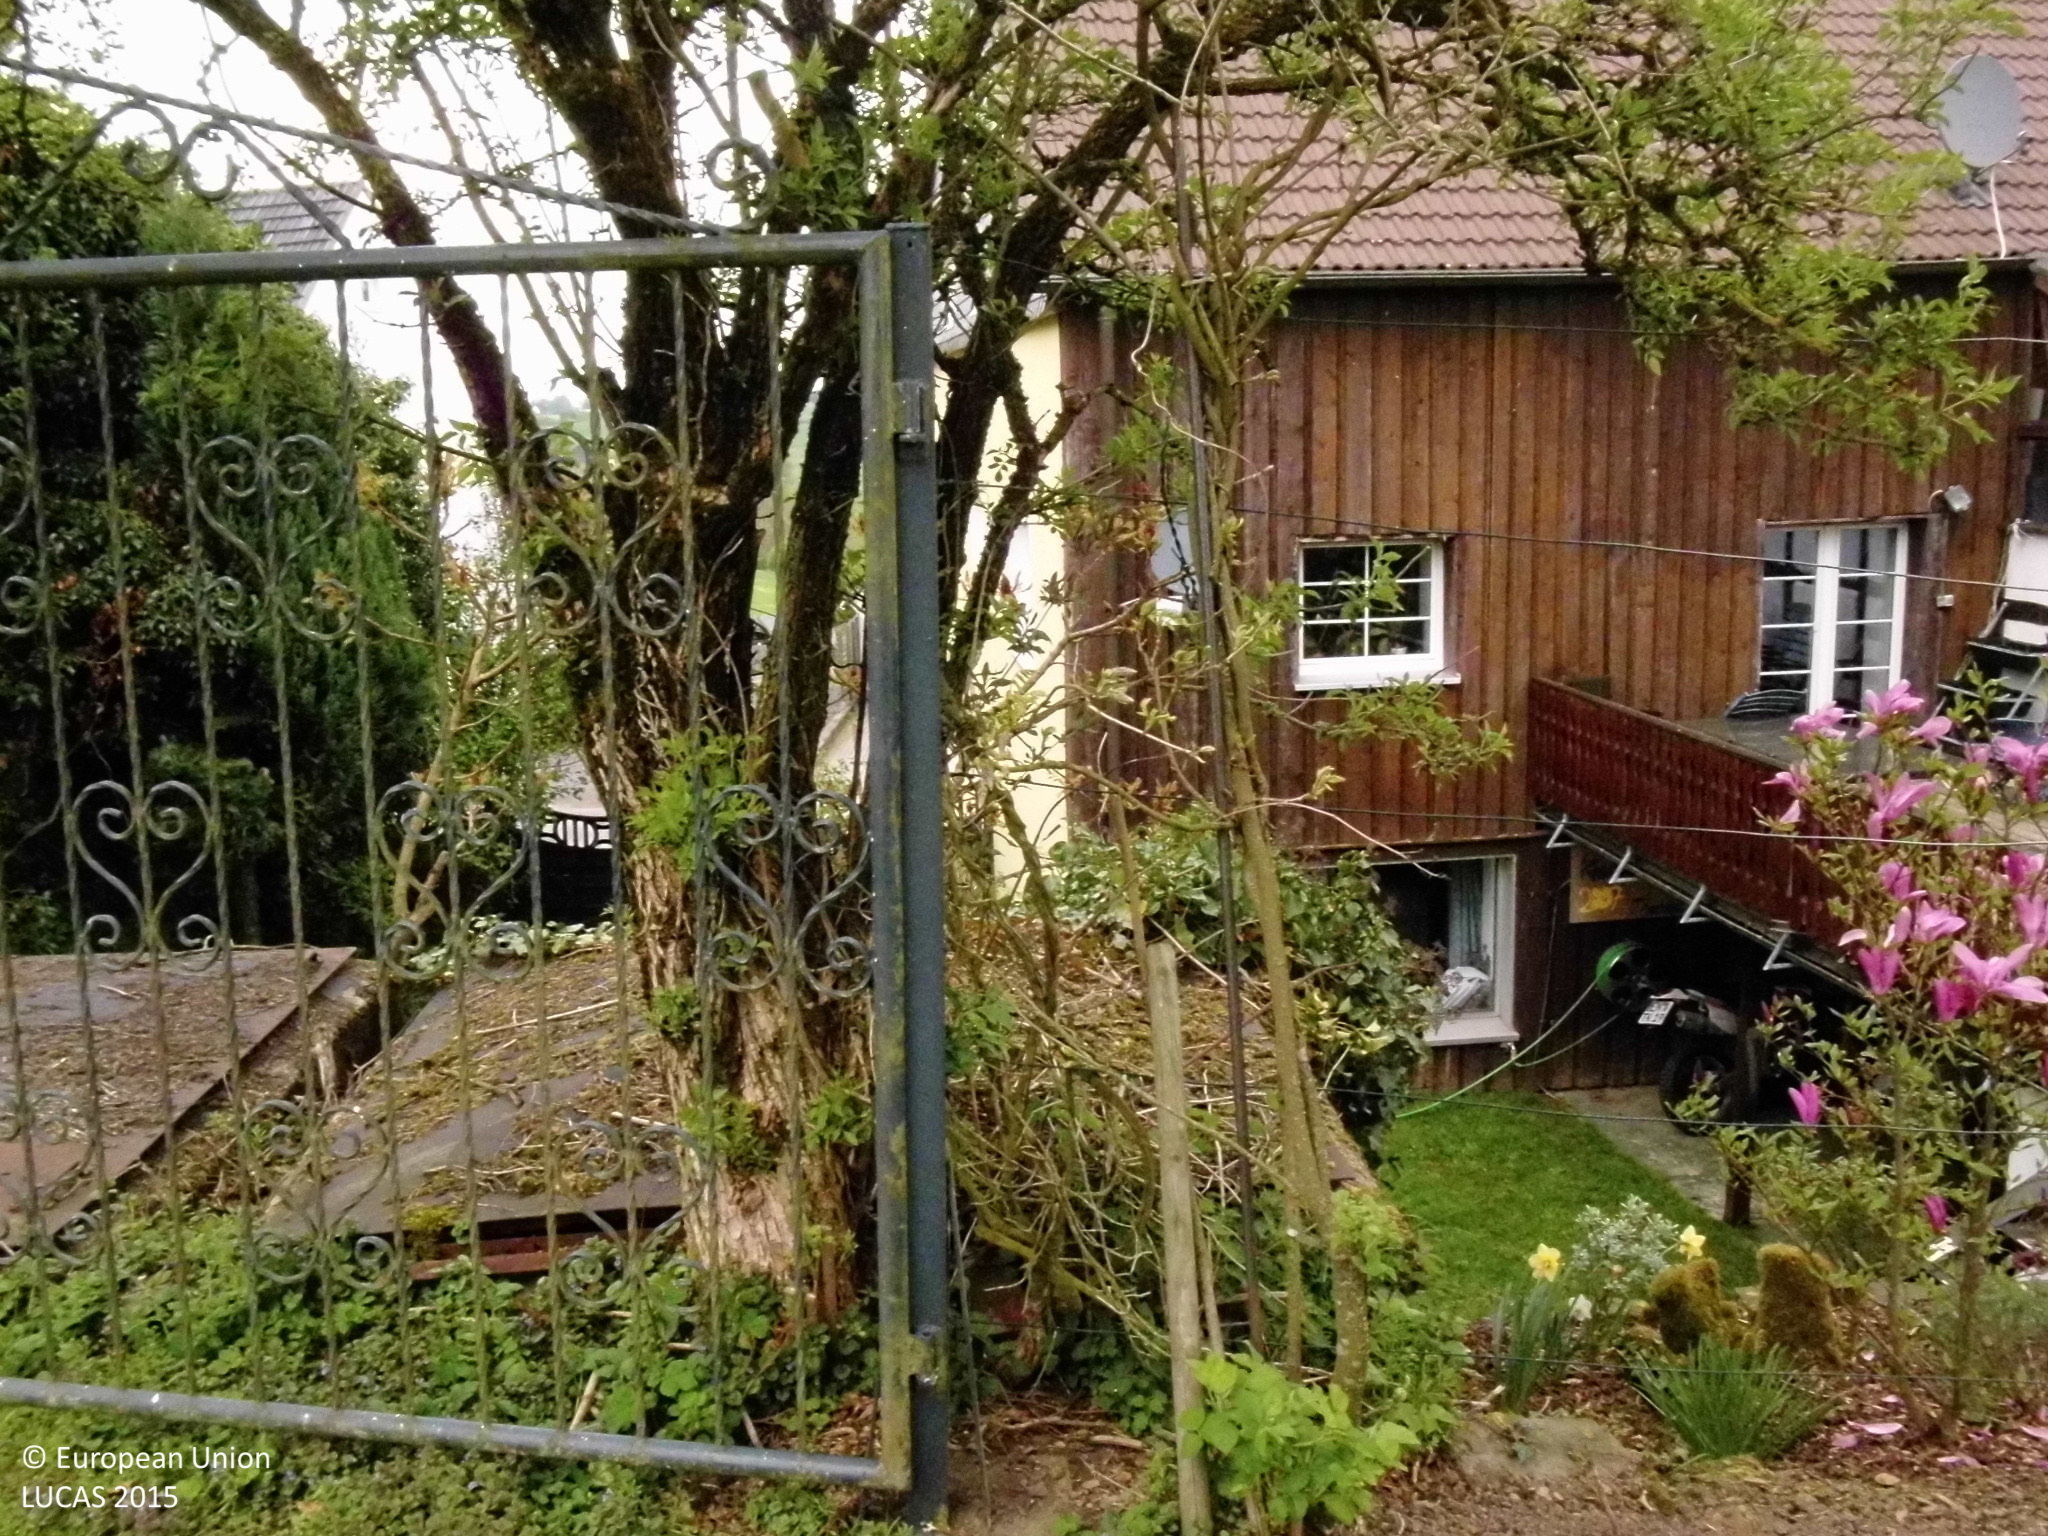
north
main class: Grassland
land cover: Grassland without tree/shrub cover
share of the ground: > 75 %
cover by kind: herbaceous plants 100 %
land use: Residential
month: May
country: DE
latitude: 51.2707
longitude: 7.4345
